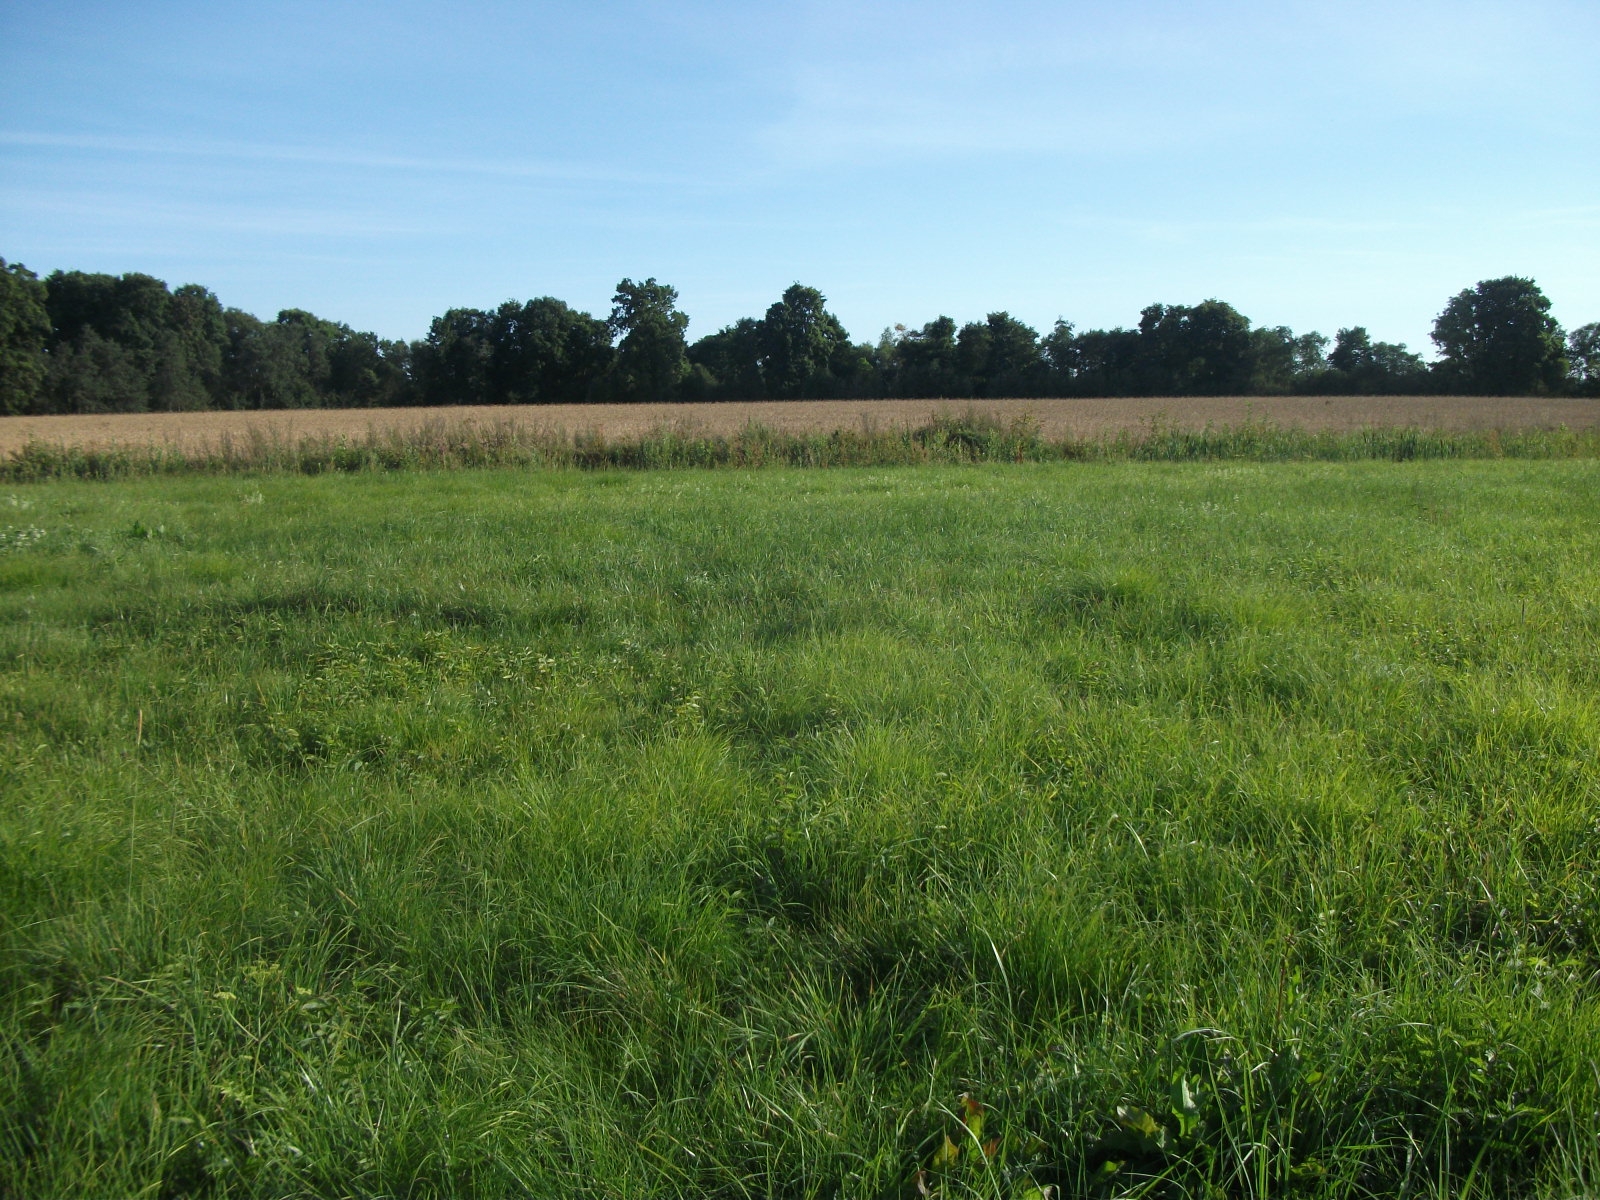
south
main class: Grassland
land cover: Grassland without tree/shrub cover
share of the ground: > 75 %
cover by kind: herbaceous plants 100 %
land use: Agriculture (excluding fallow land and kitchen gardens)
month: August
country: LV
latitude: 56.3774
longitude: 26.2200
